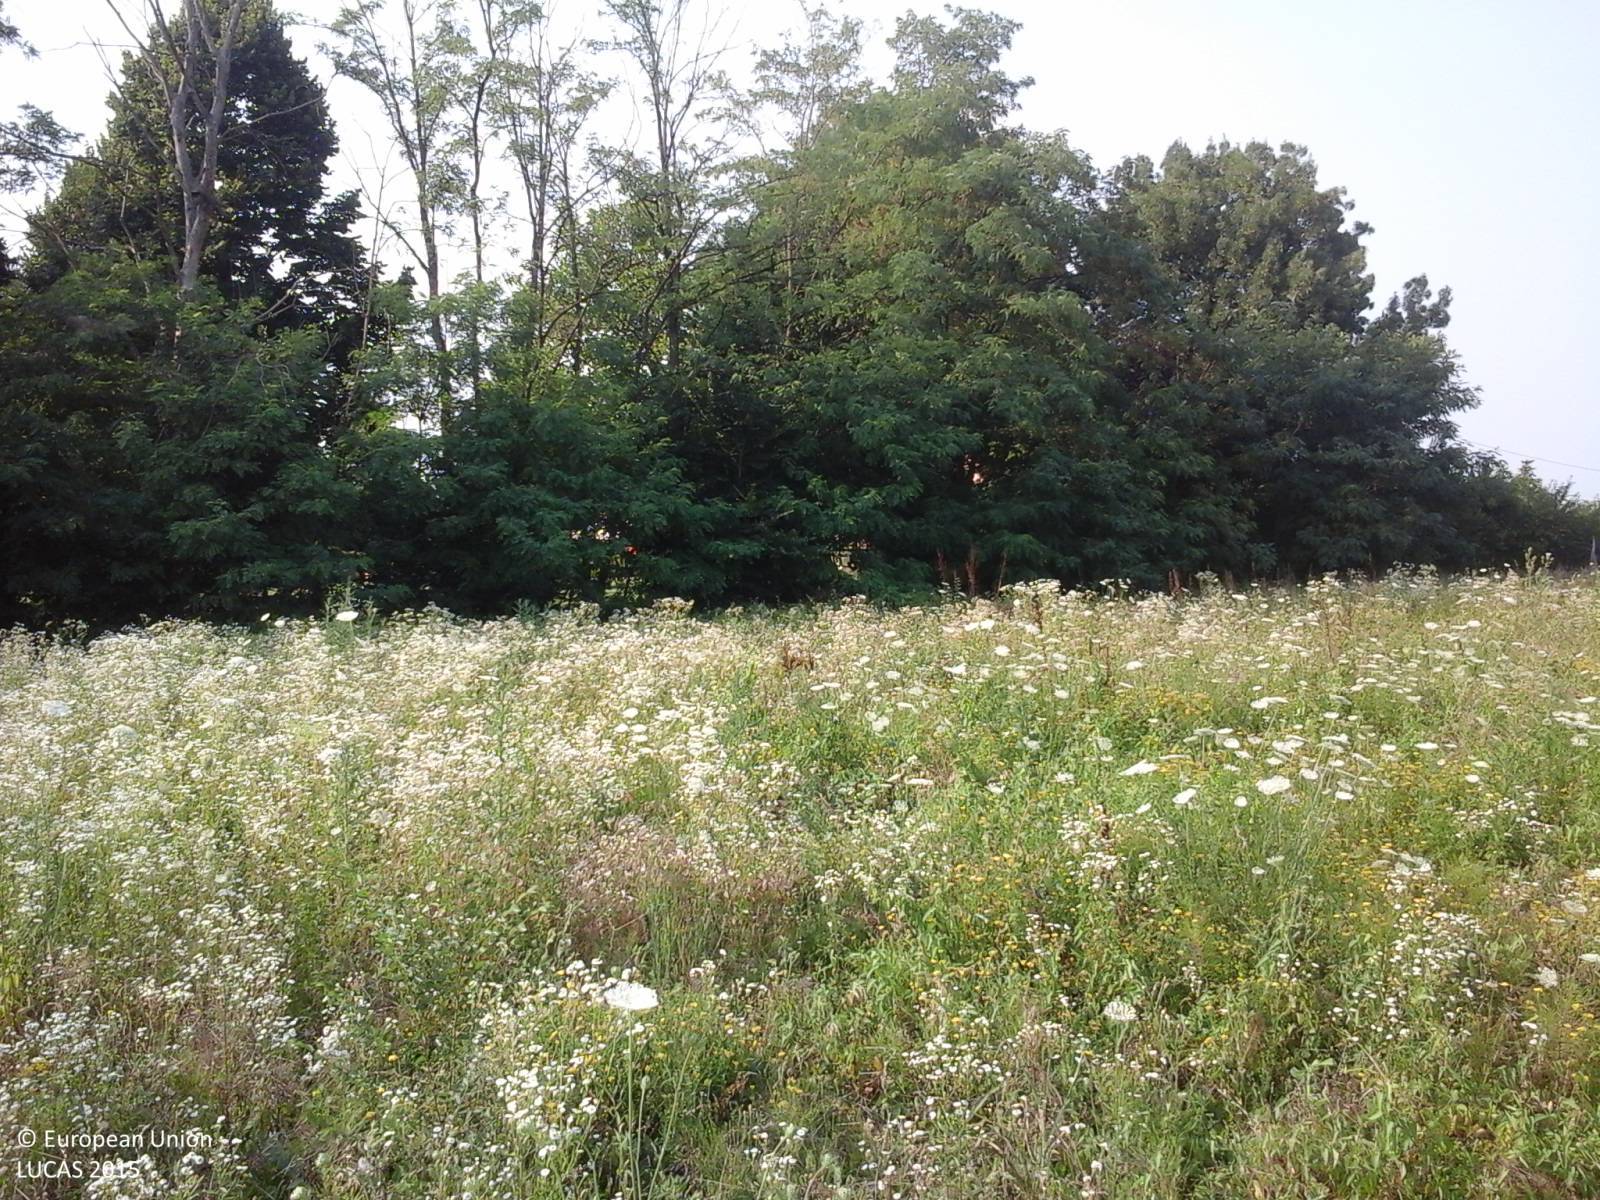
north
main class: Grassland
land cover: Spontaneously vegetated surfaces
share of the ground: > 75 %
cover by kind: herbaceous plants 100 %
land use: Fallow land
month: July
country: IT
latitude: 45.9022
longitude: 12.7162
